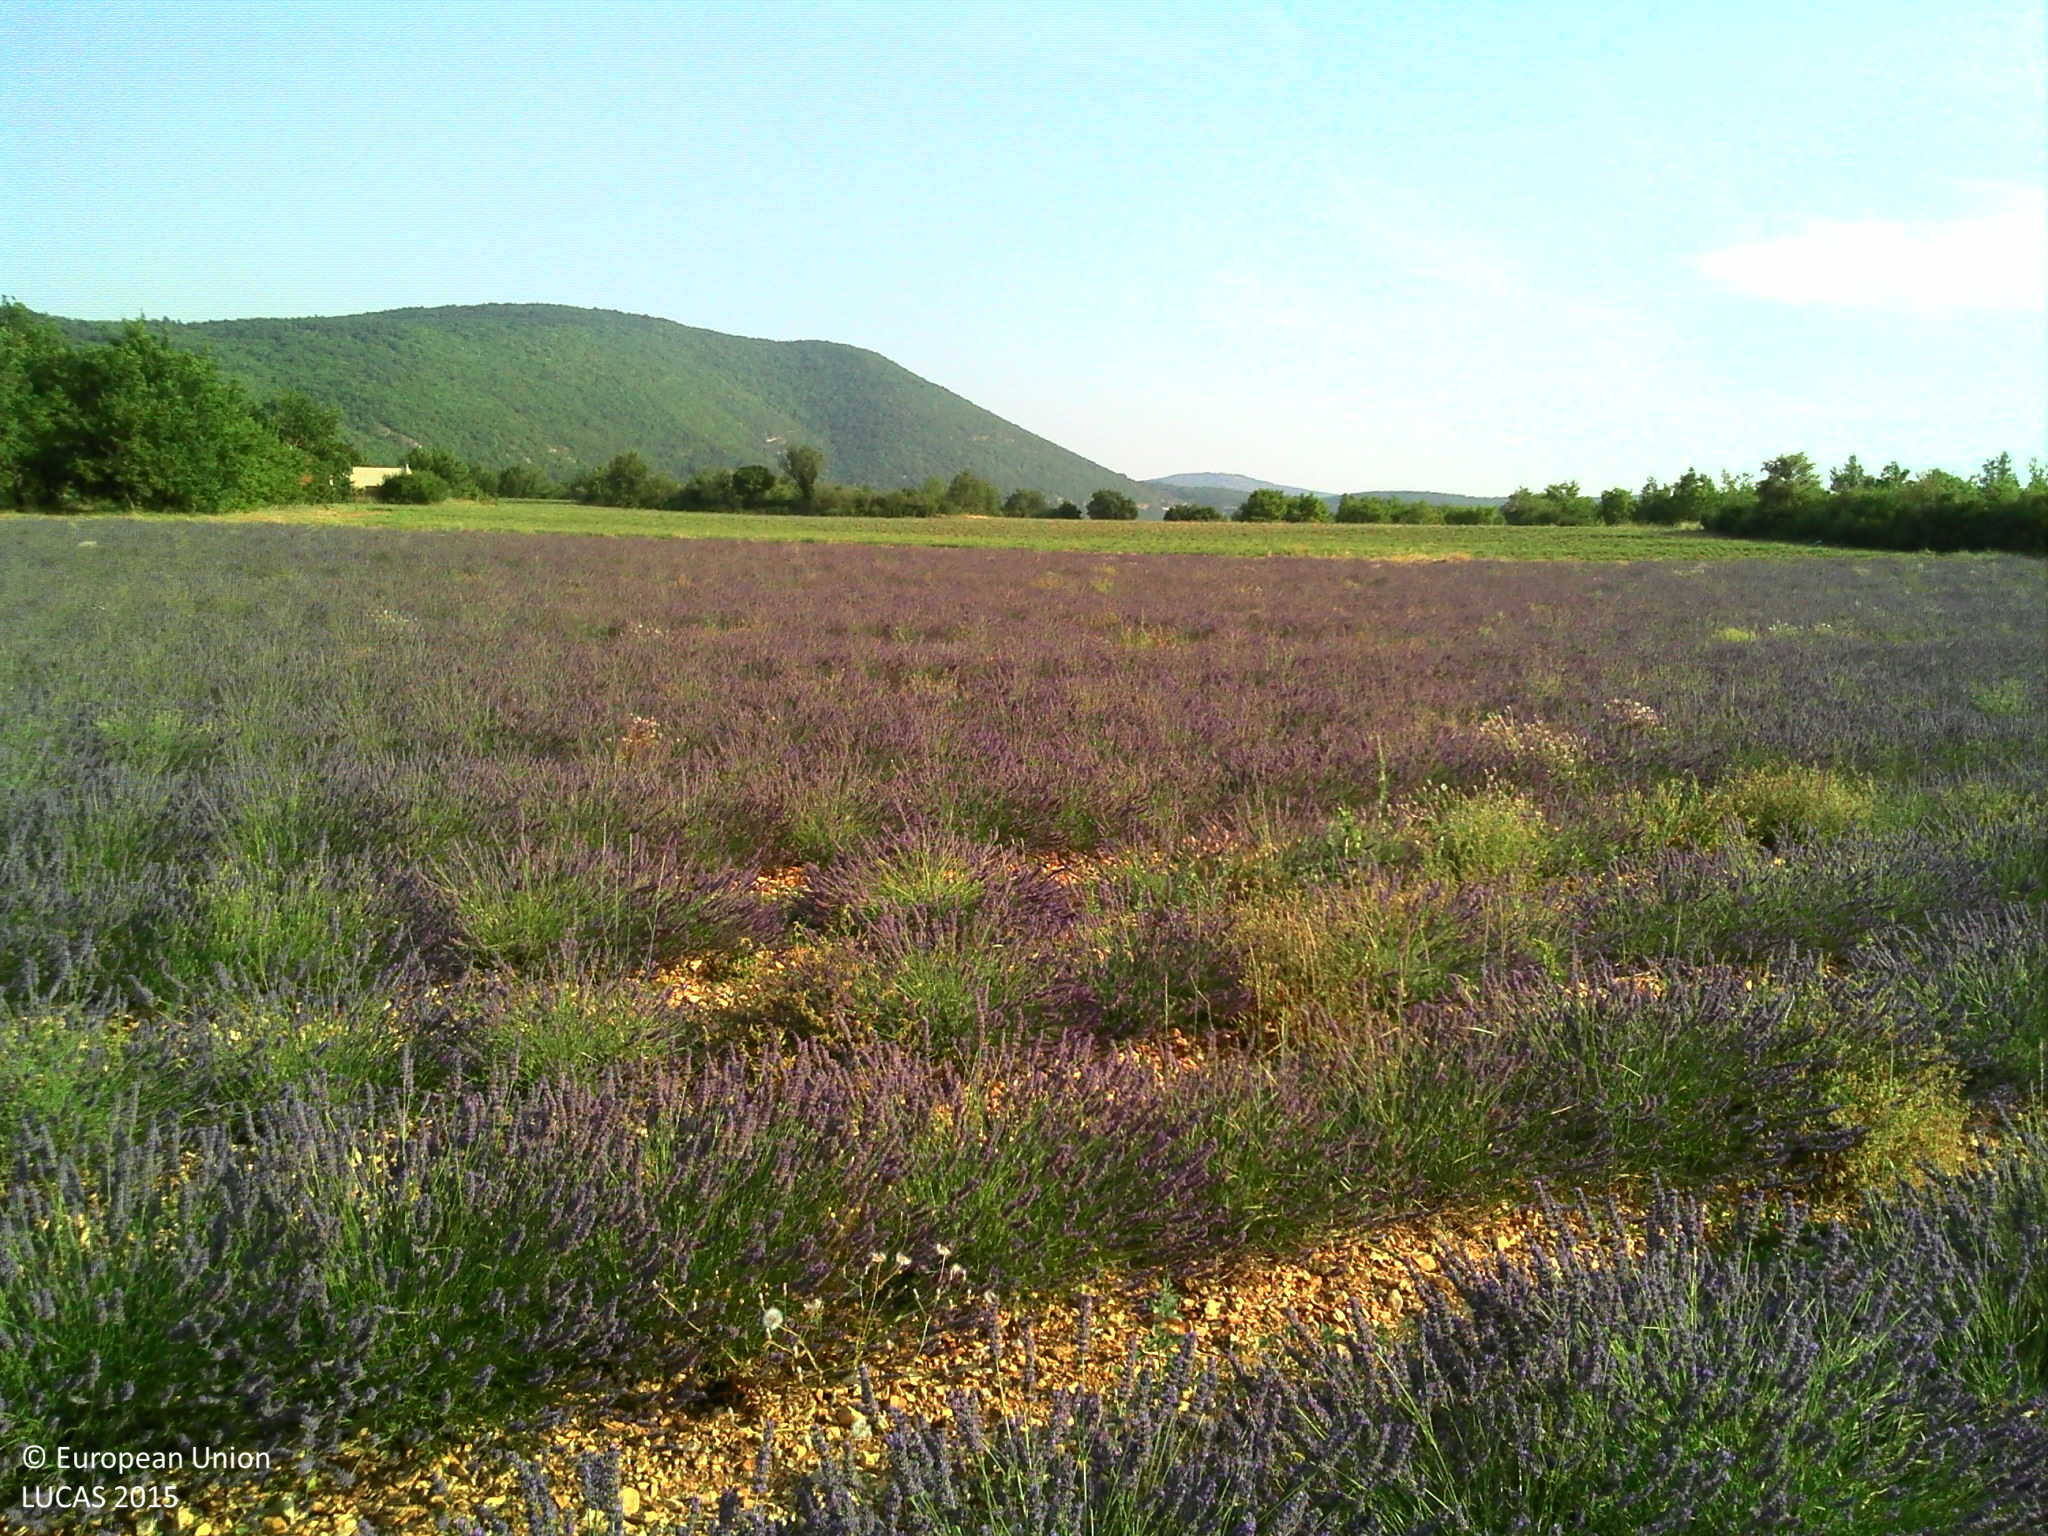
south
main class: Cropland
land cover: Permanent industrial crops
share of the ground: > 75 %
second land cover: Other bare soil
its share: > 75 %
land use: Agriculture (excluding fallow land and kitchen gardens)
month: July
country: FR
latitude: 44.0860
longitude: 5.3997
